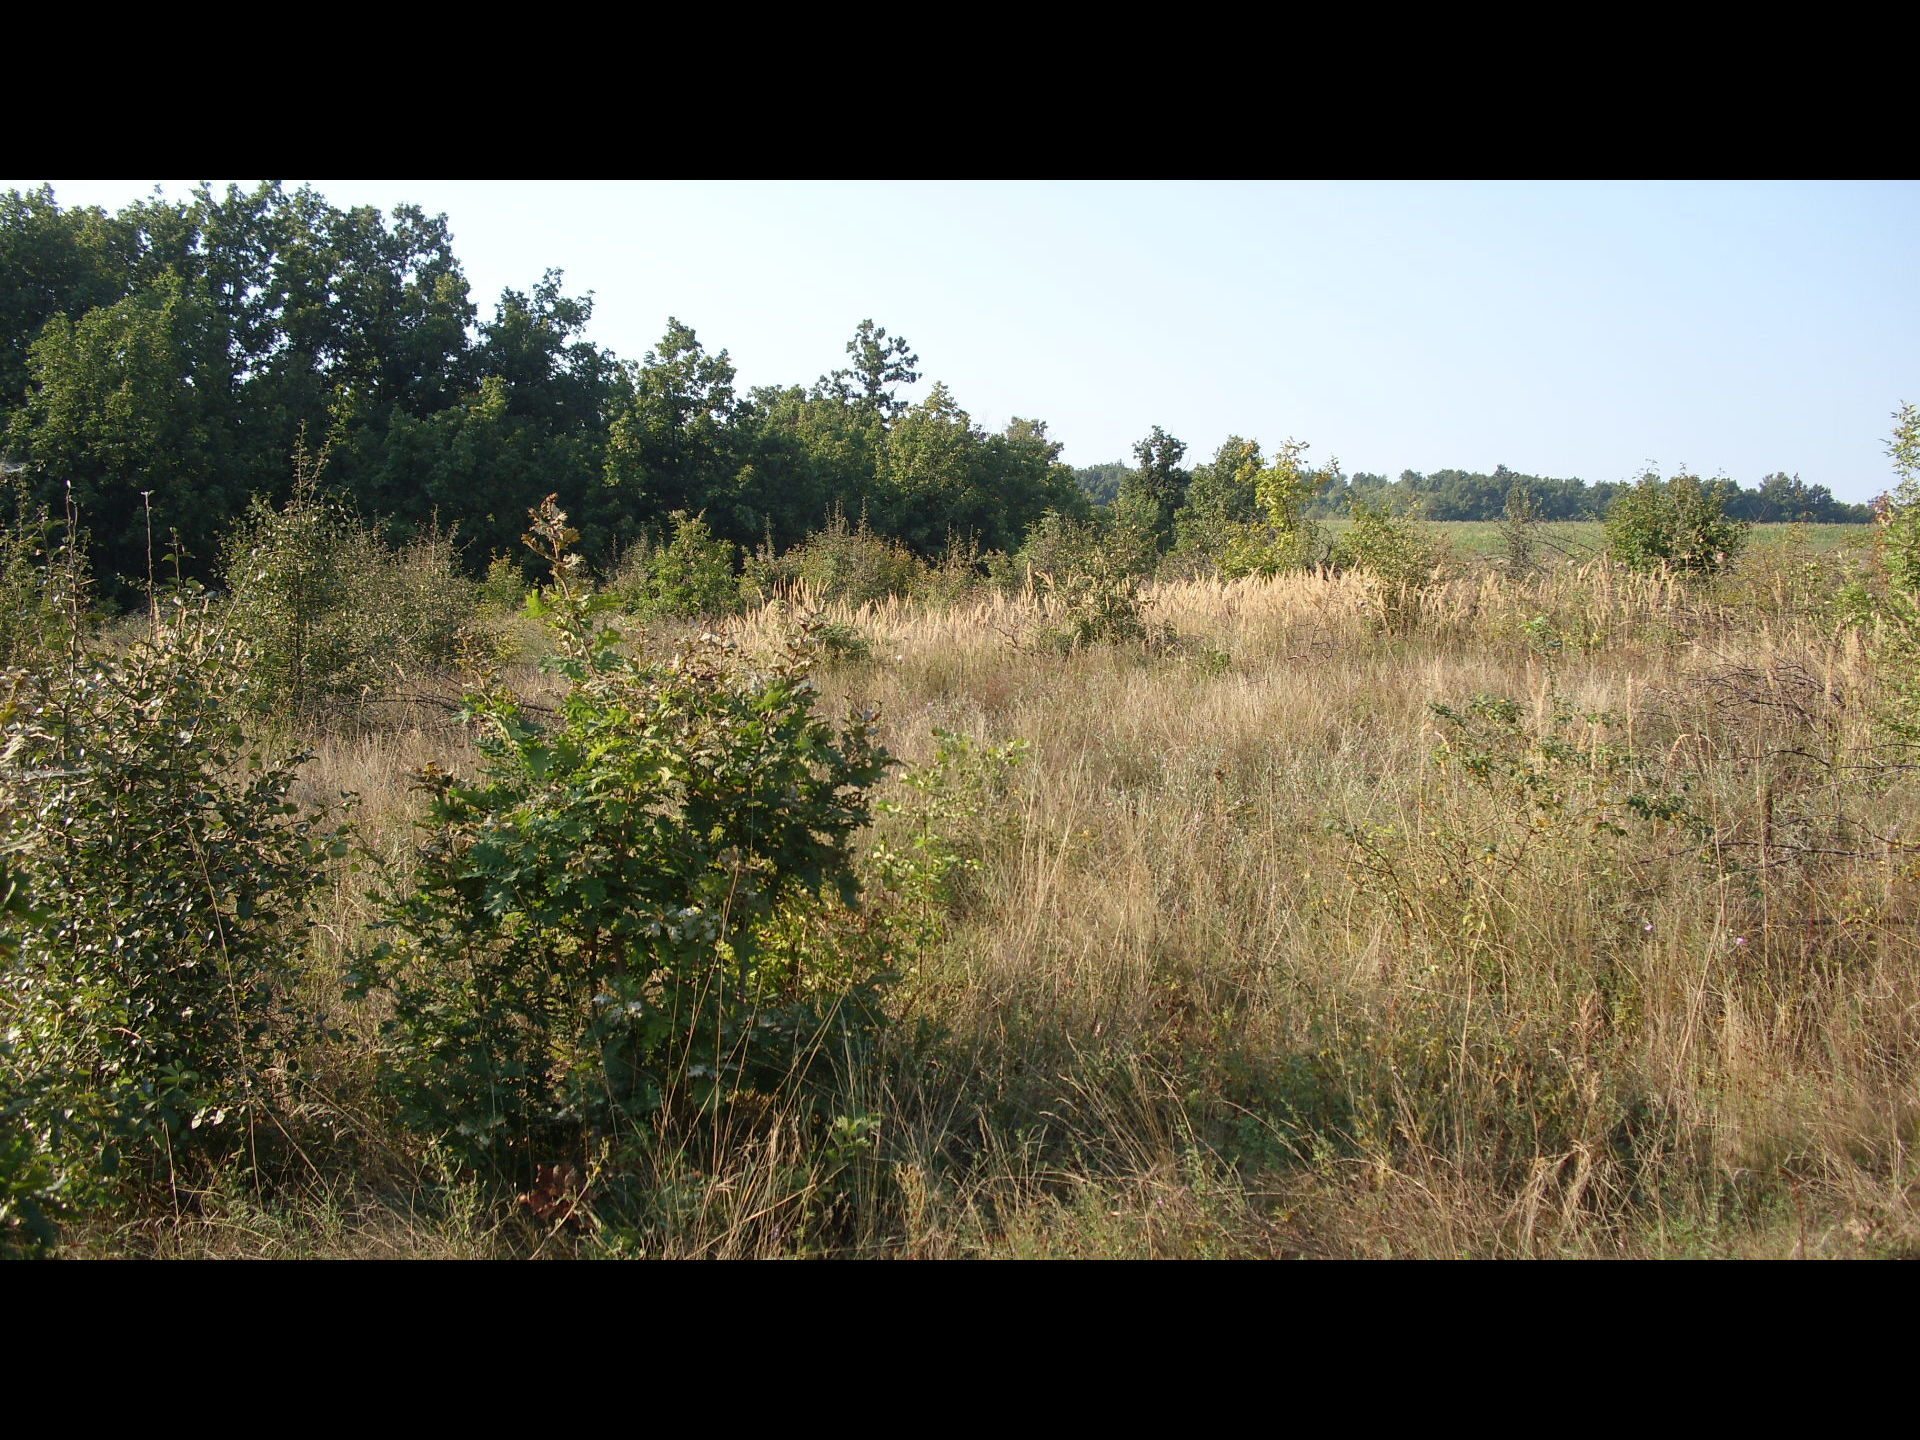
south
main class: Shrubland
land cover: Shrubland with sparse tree cover
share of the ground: 50 - 75 %
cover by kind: shrubs 65 %, herbaceous plants 30 %, broadleaved forest trees 5 %
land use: Agriculture (excluding fallow land and kitchen gardens)
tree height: < 5 m
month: September
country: BG
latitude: 44.0820
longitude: 22.6628
